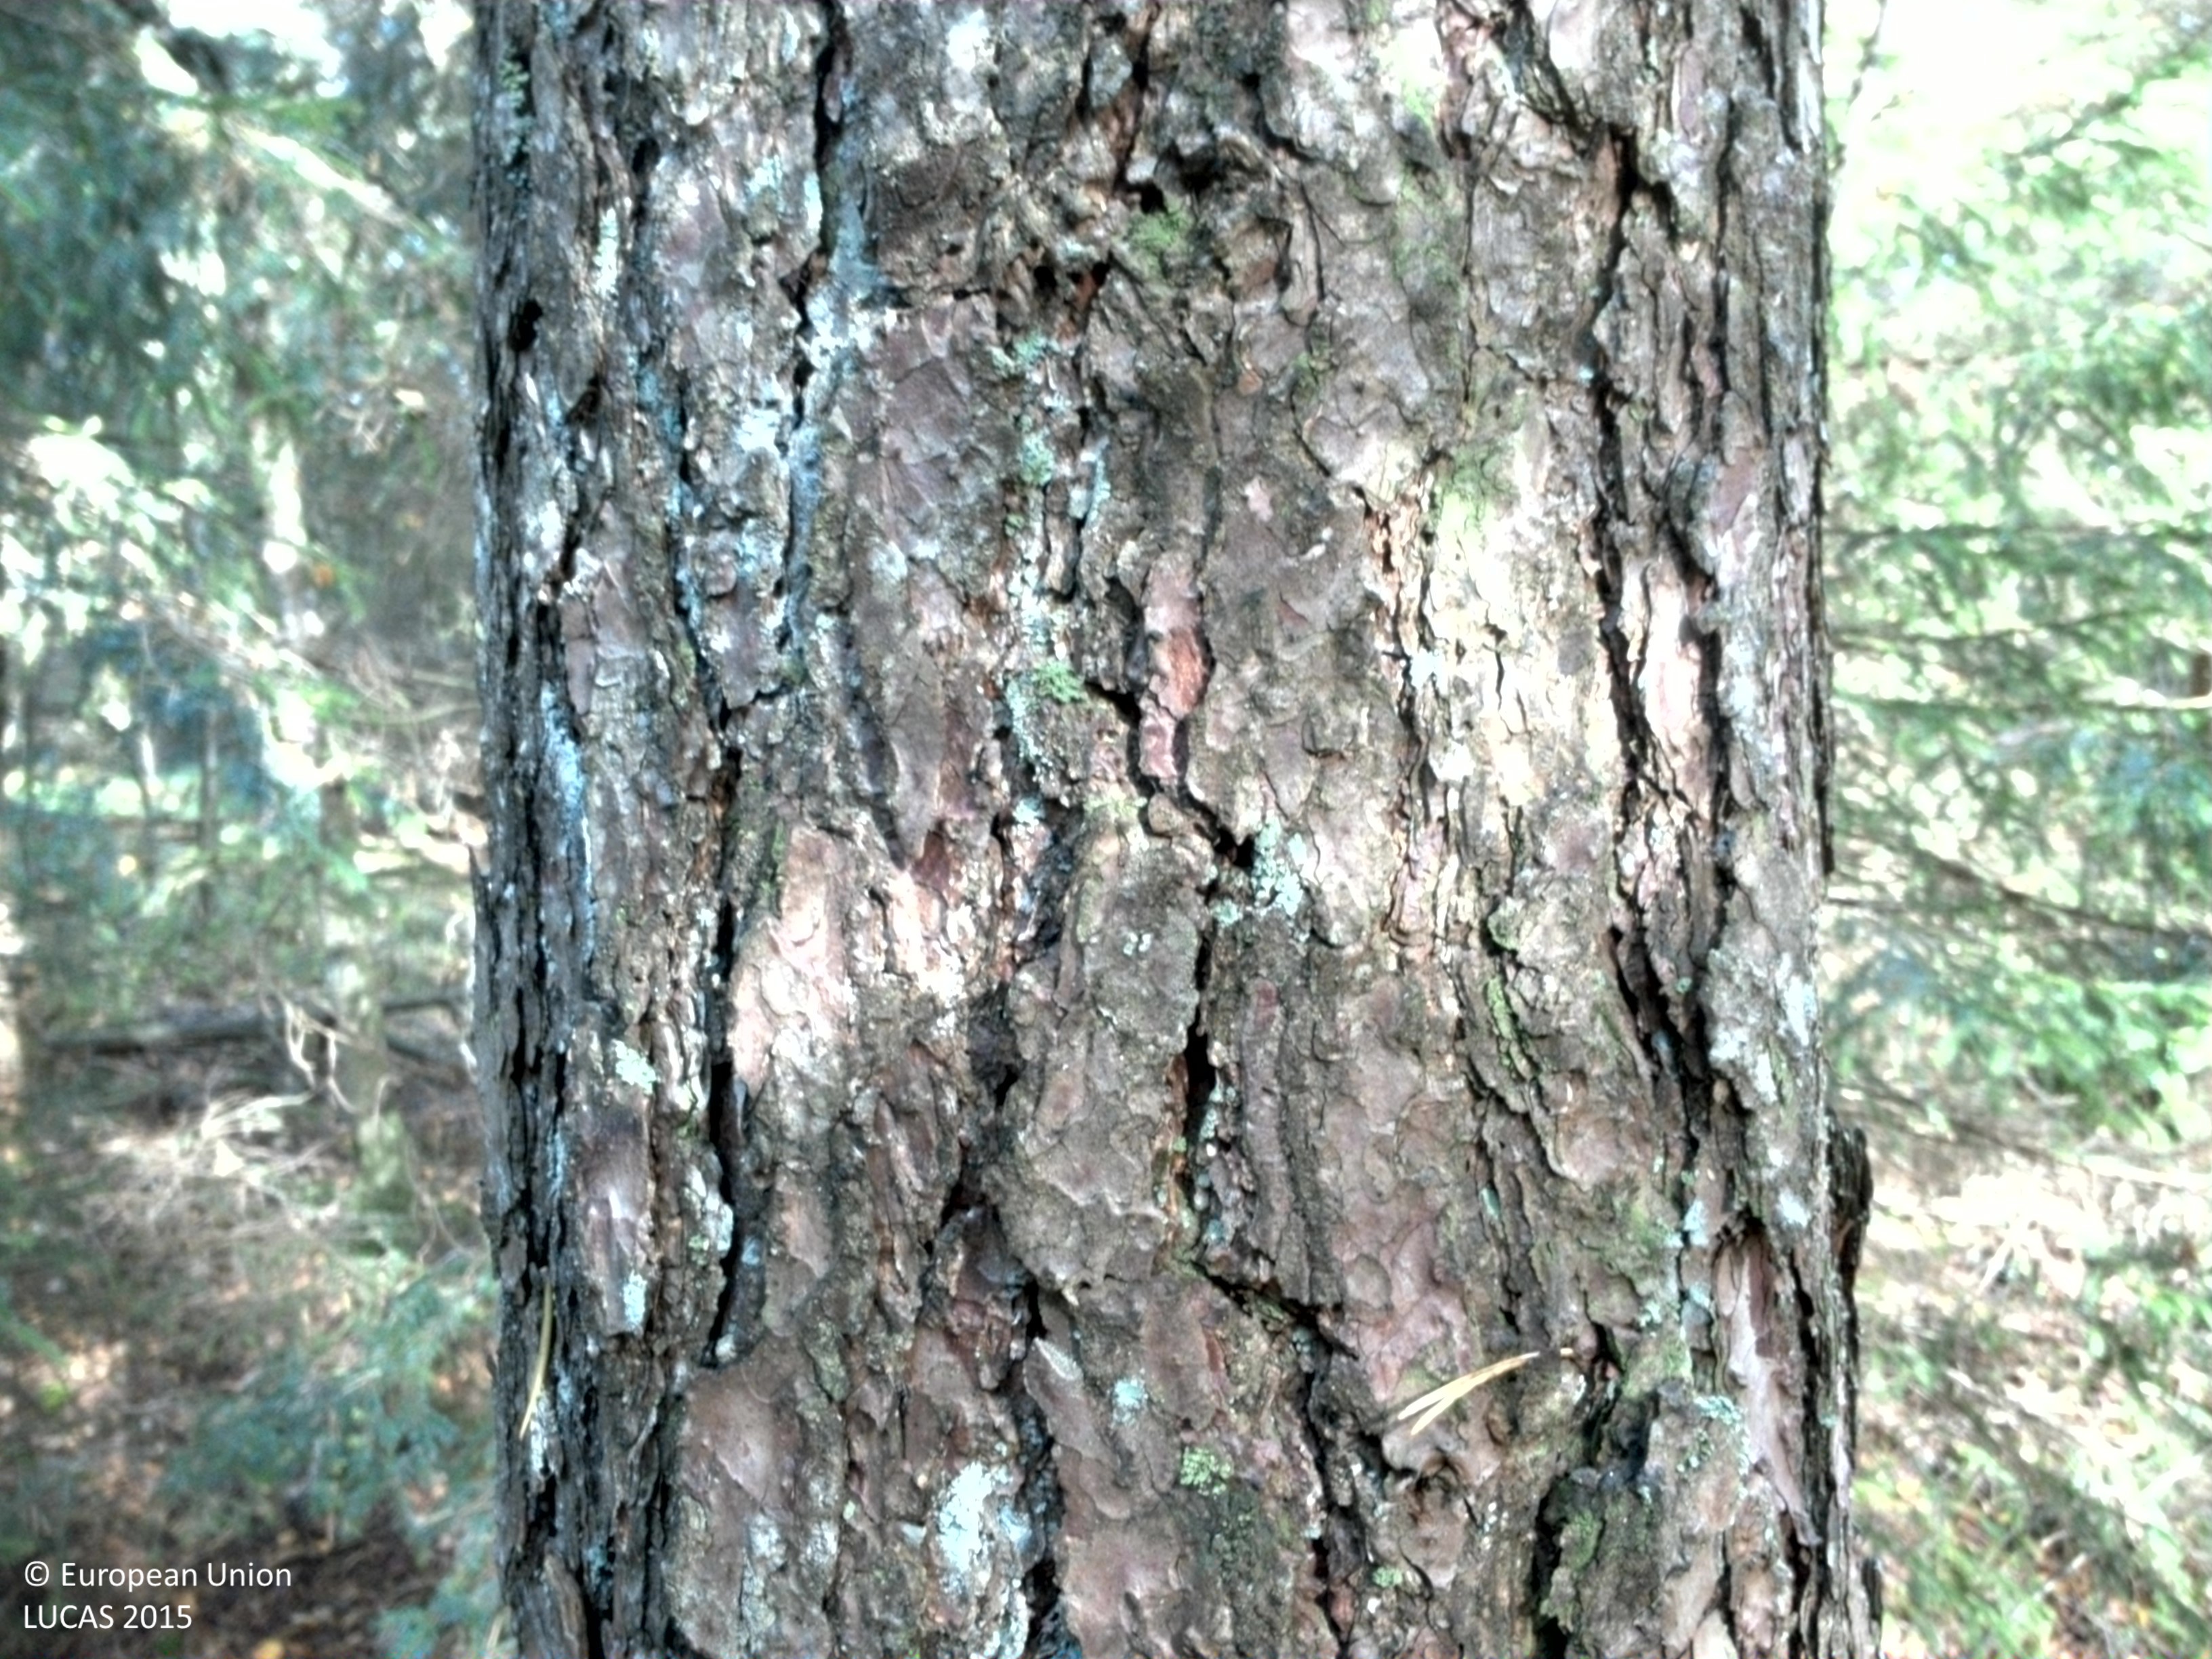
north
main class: Woodland
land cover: Pine dominated coniferous woodland
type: boreal forest
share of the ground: > 75 %
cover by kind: coniferous forest trees 85 %, broadleaved forest trees 5 %, shrubs 5 %, lichens and mosses 5 %
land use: Forestry
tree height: > 5 m
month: September
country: SE
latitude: 58.0032
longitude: 13.1253
